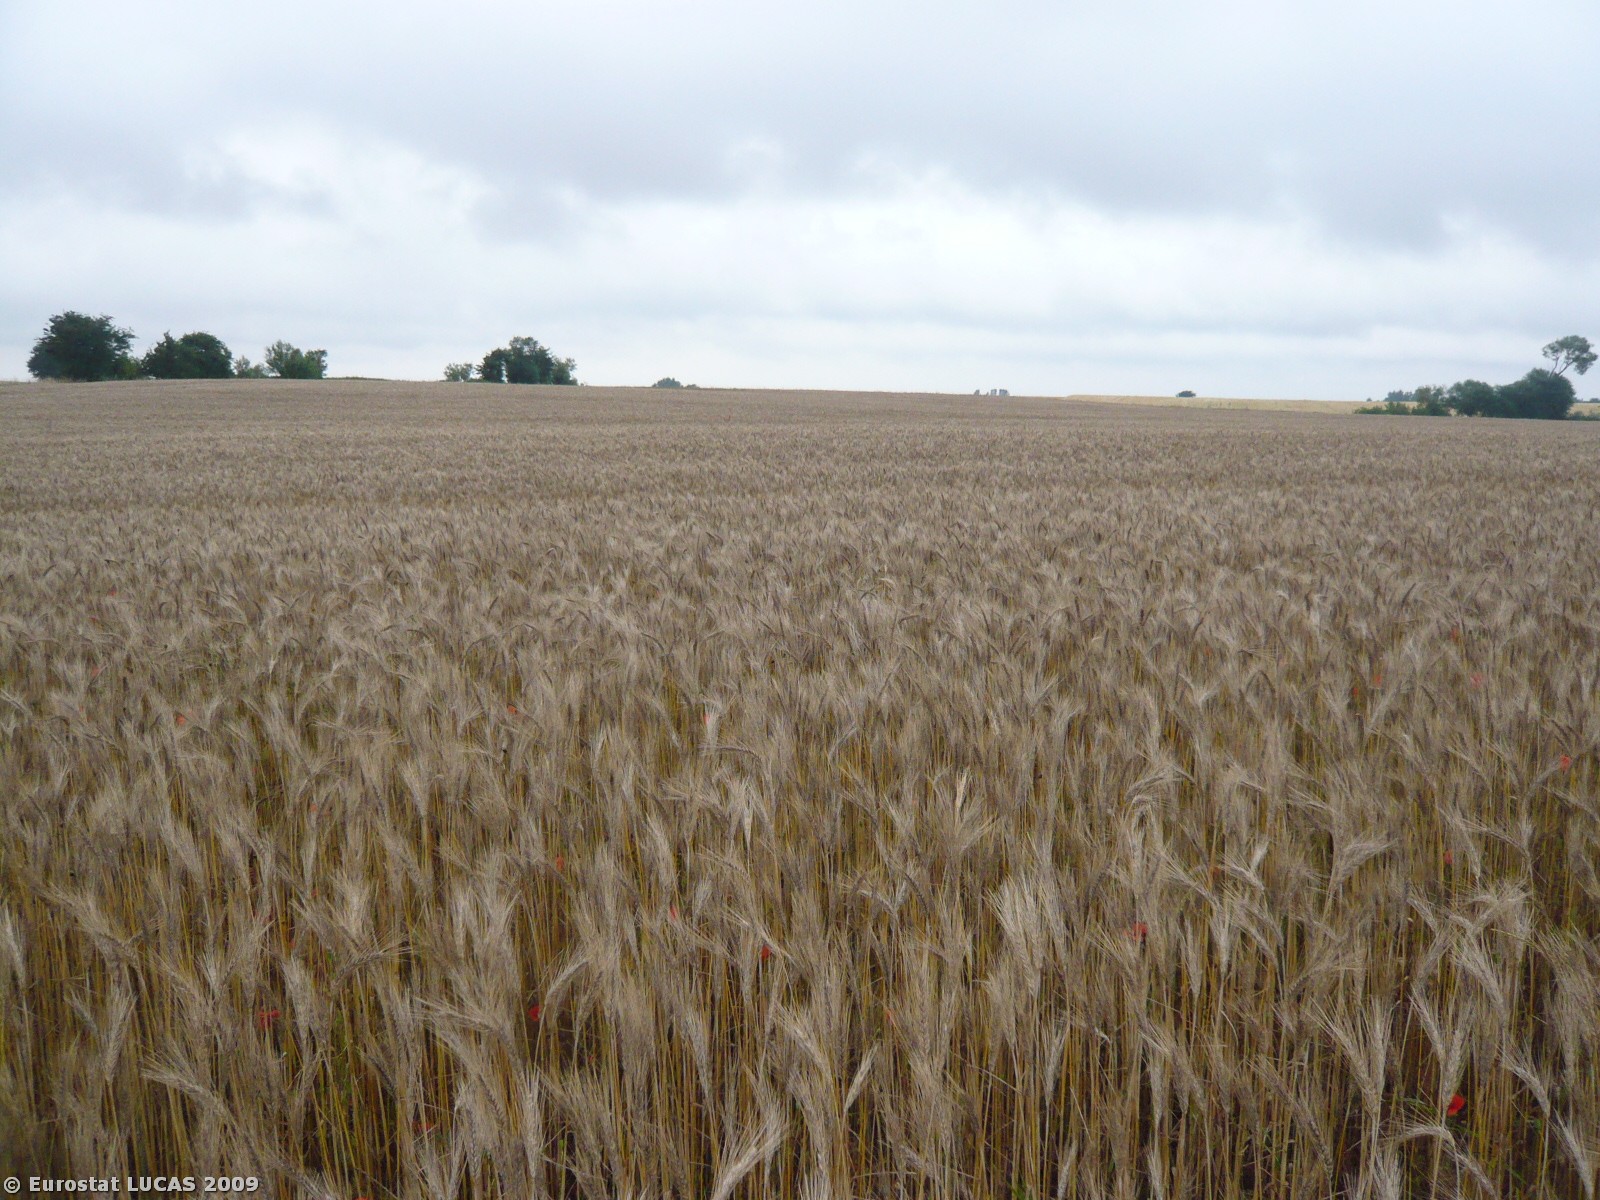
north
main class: Cropland
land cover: Durum wheat
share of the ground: > 75 %
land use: Agriculture (excluding fallow land and kitchen gardens)
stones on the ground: < 10 %
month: July
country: DK
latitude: 55.6699
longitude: 11.9221
